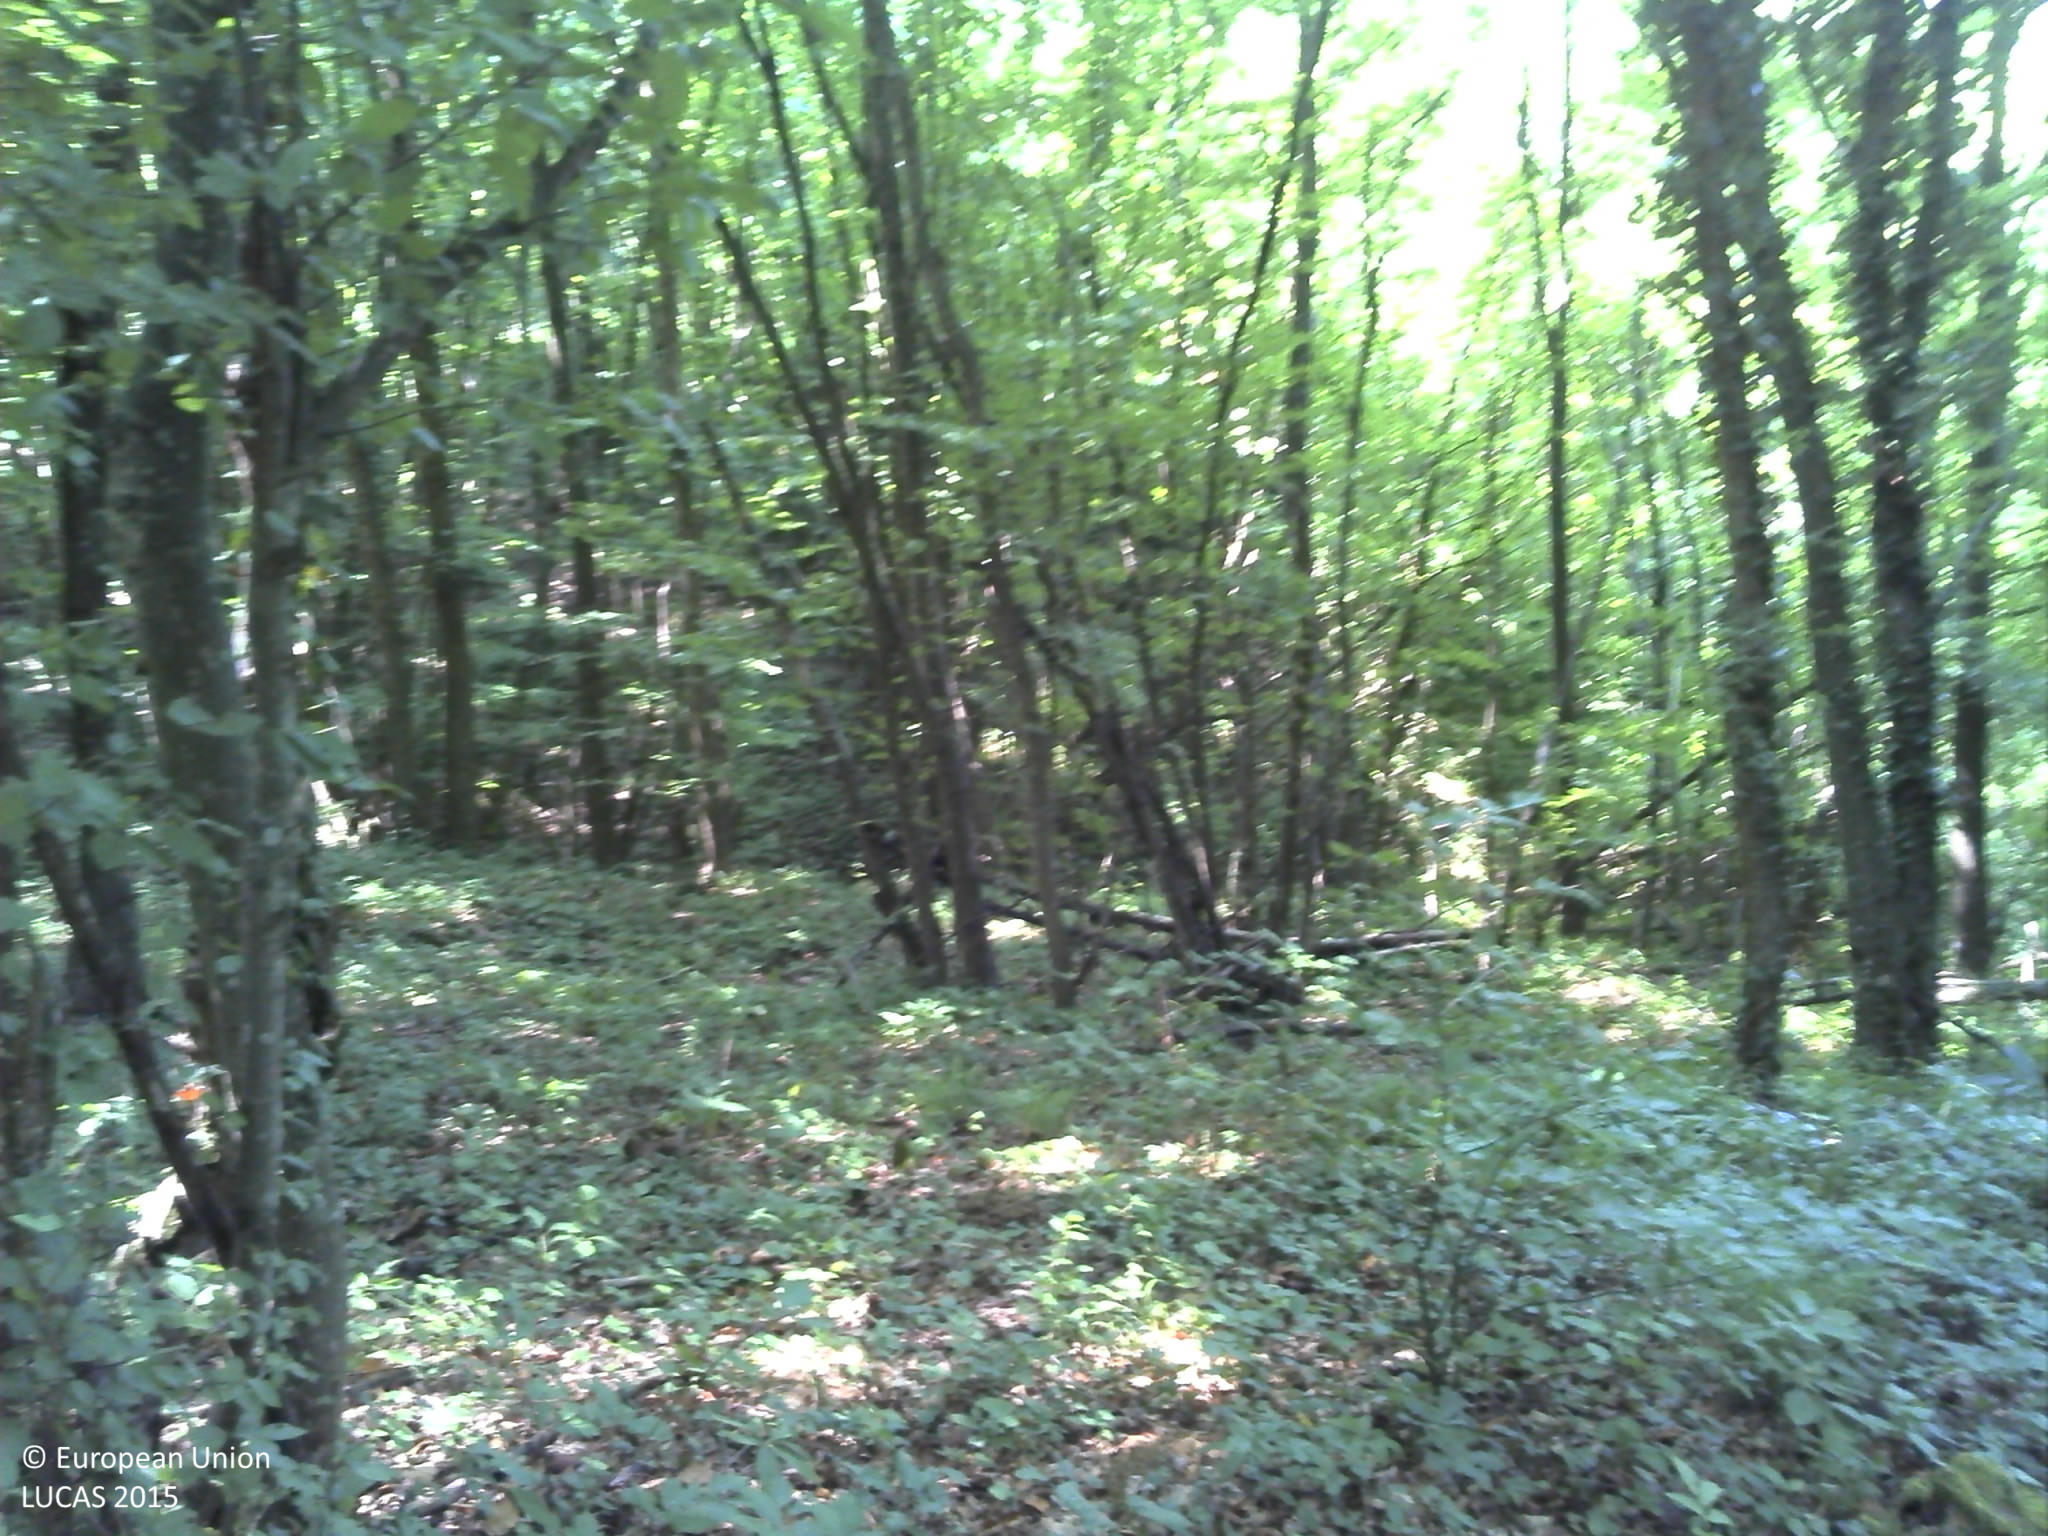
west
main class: Woodland
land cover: Broadleaved woodland
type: acidophilous oak and oak-birch forest
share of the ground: > 75 %
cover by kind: broadleaved forest trees 95 %, shrubs 5 %
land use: Forestry
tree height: > 5 m
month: June
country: HR
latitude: 45.2592
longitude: 17.9416
